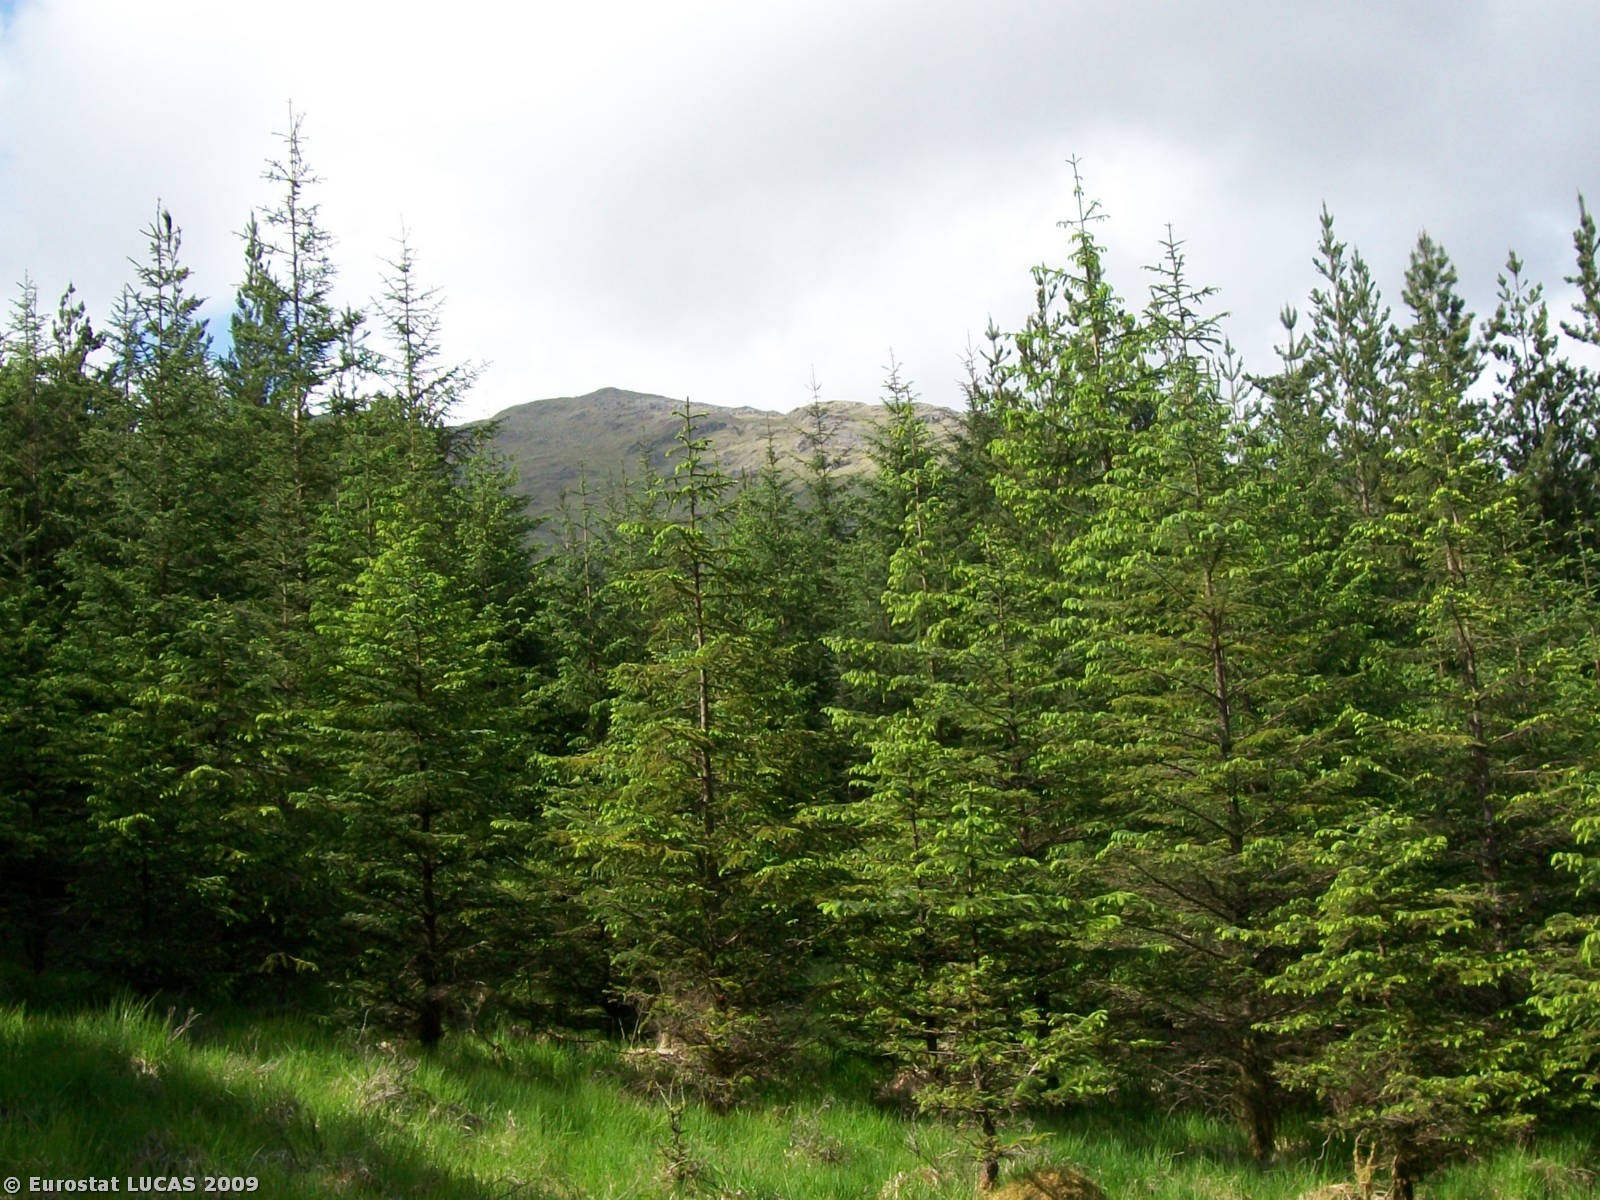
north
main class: Shrubland
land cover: Shrubland without tree cover
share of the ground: 25 - 50 %
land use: Forestry
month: May
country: GB
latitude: 56.8974
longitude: -5.4341
